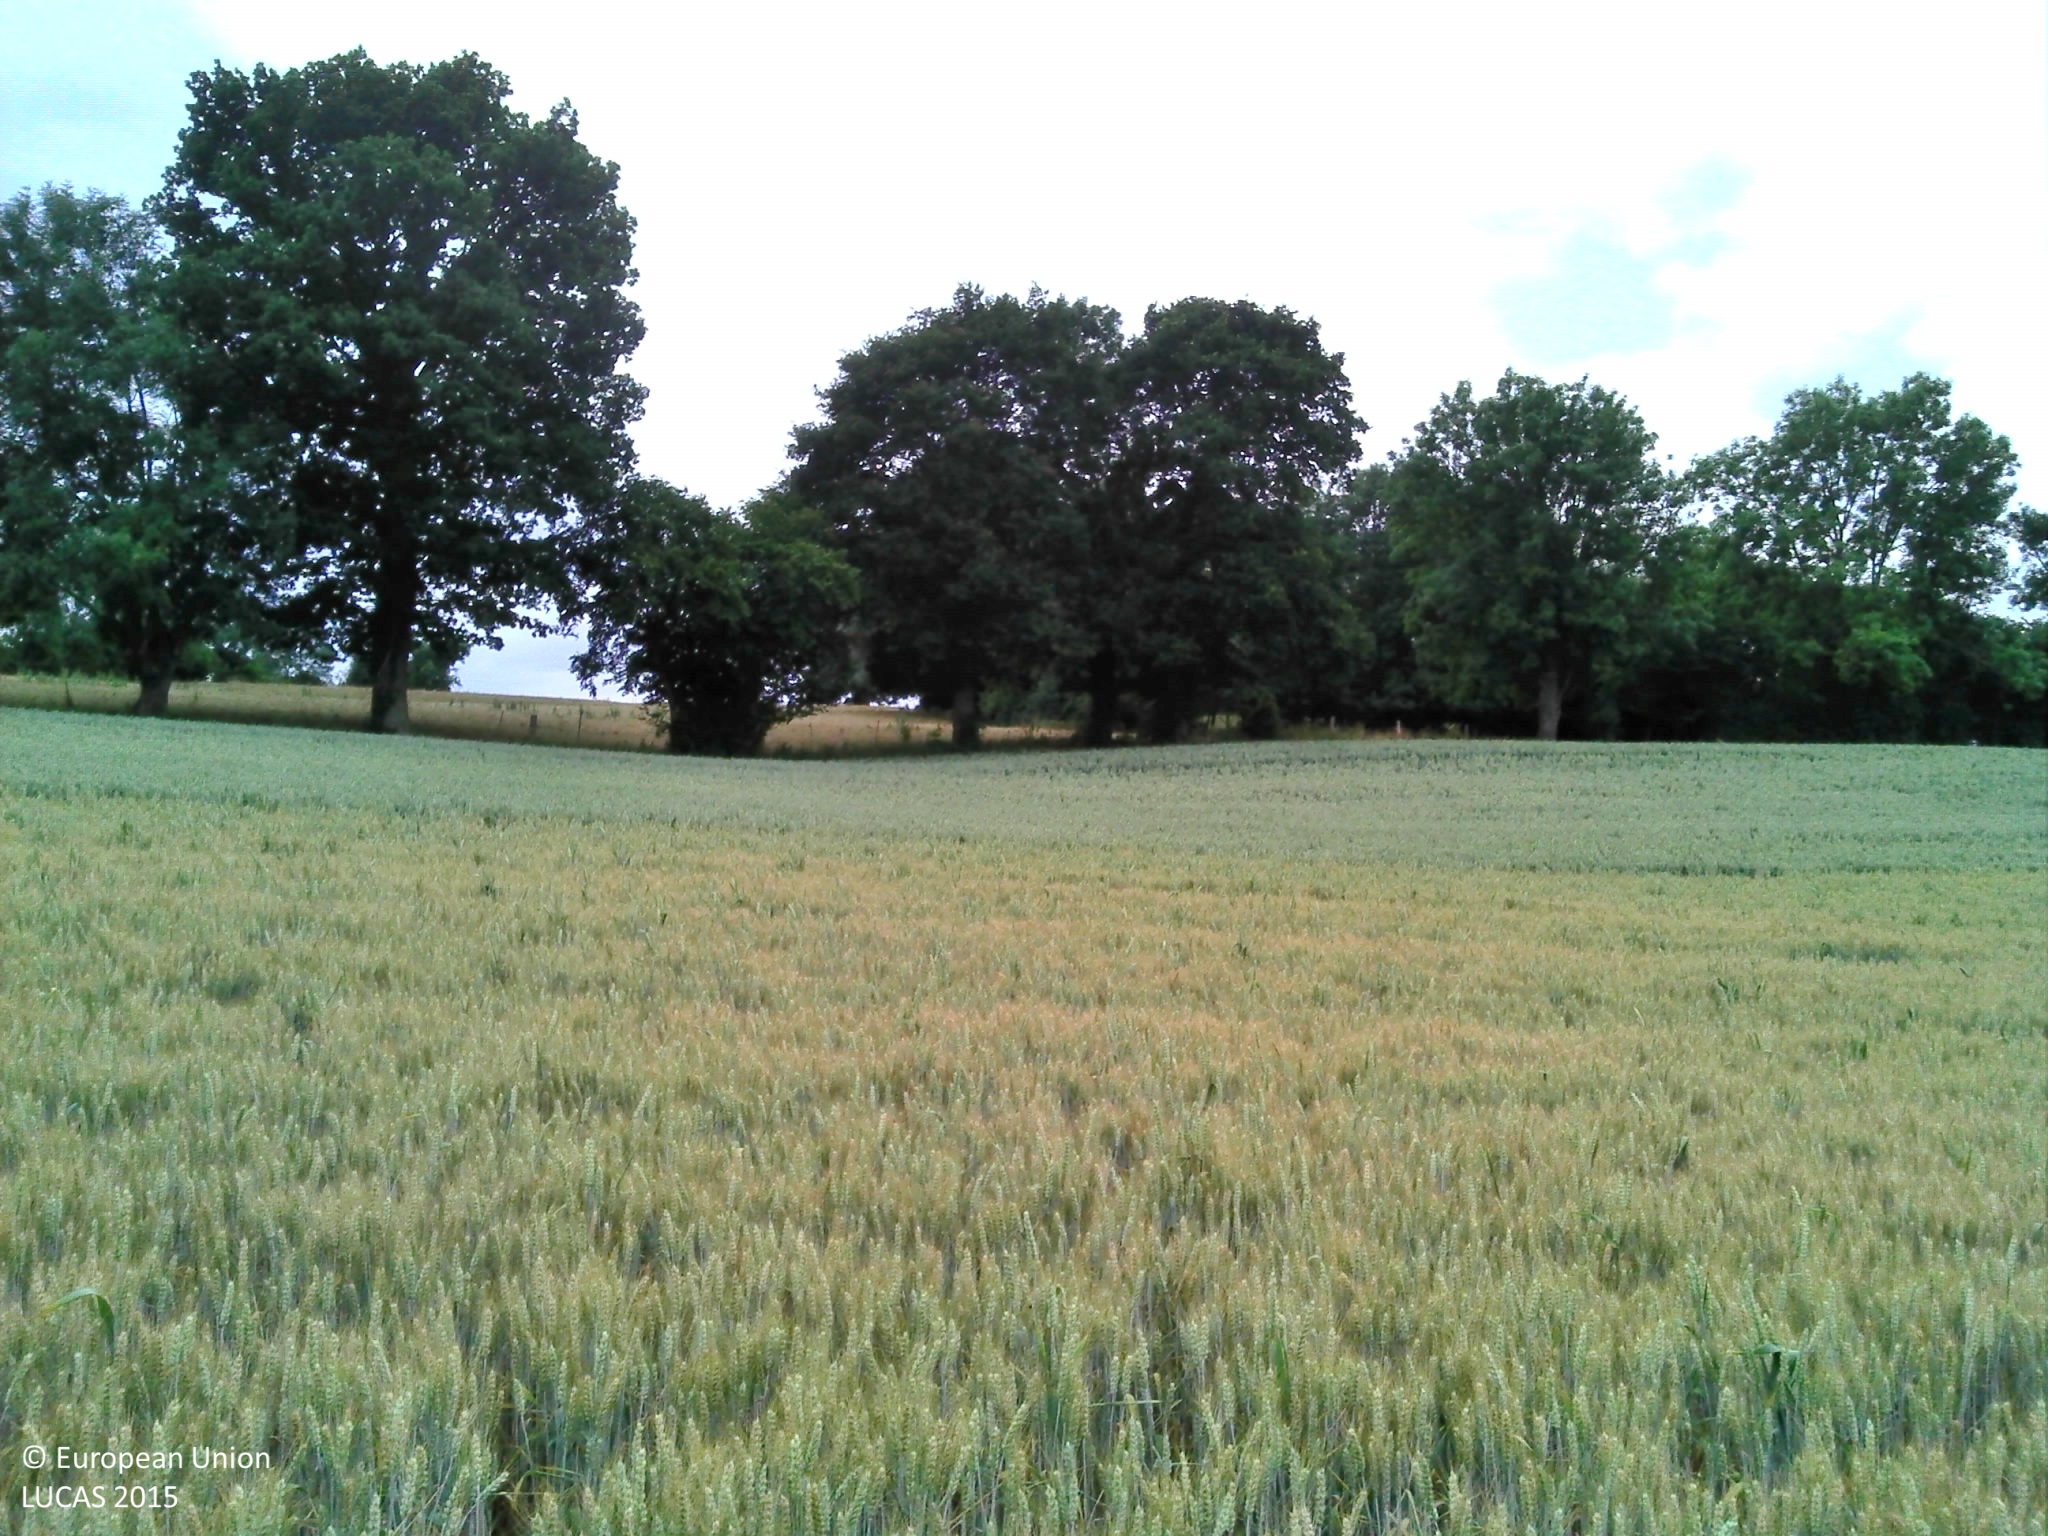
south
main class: Cropland
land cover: Common wheat
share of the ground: > 75 %
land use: Agriculture (excluding fallow land and kitchen gardens)
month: July
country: FR
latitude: 49.4906
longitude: 1.7971
